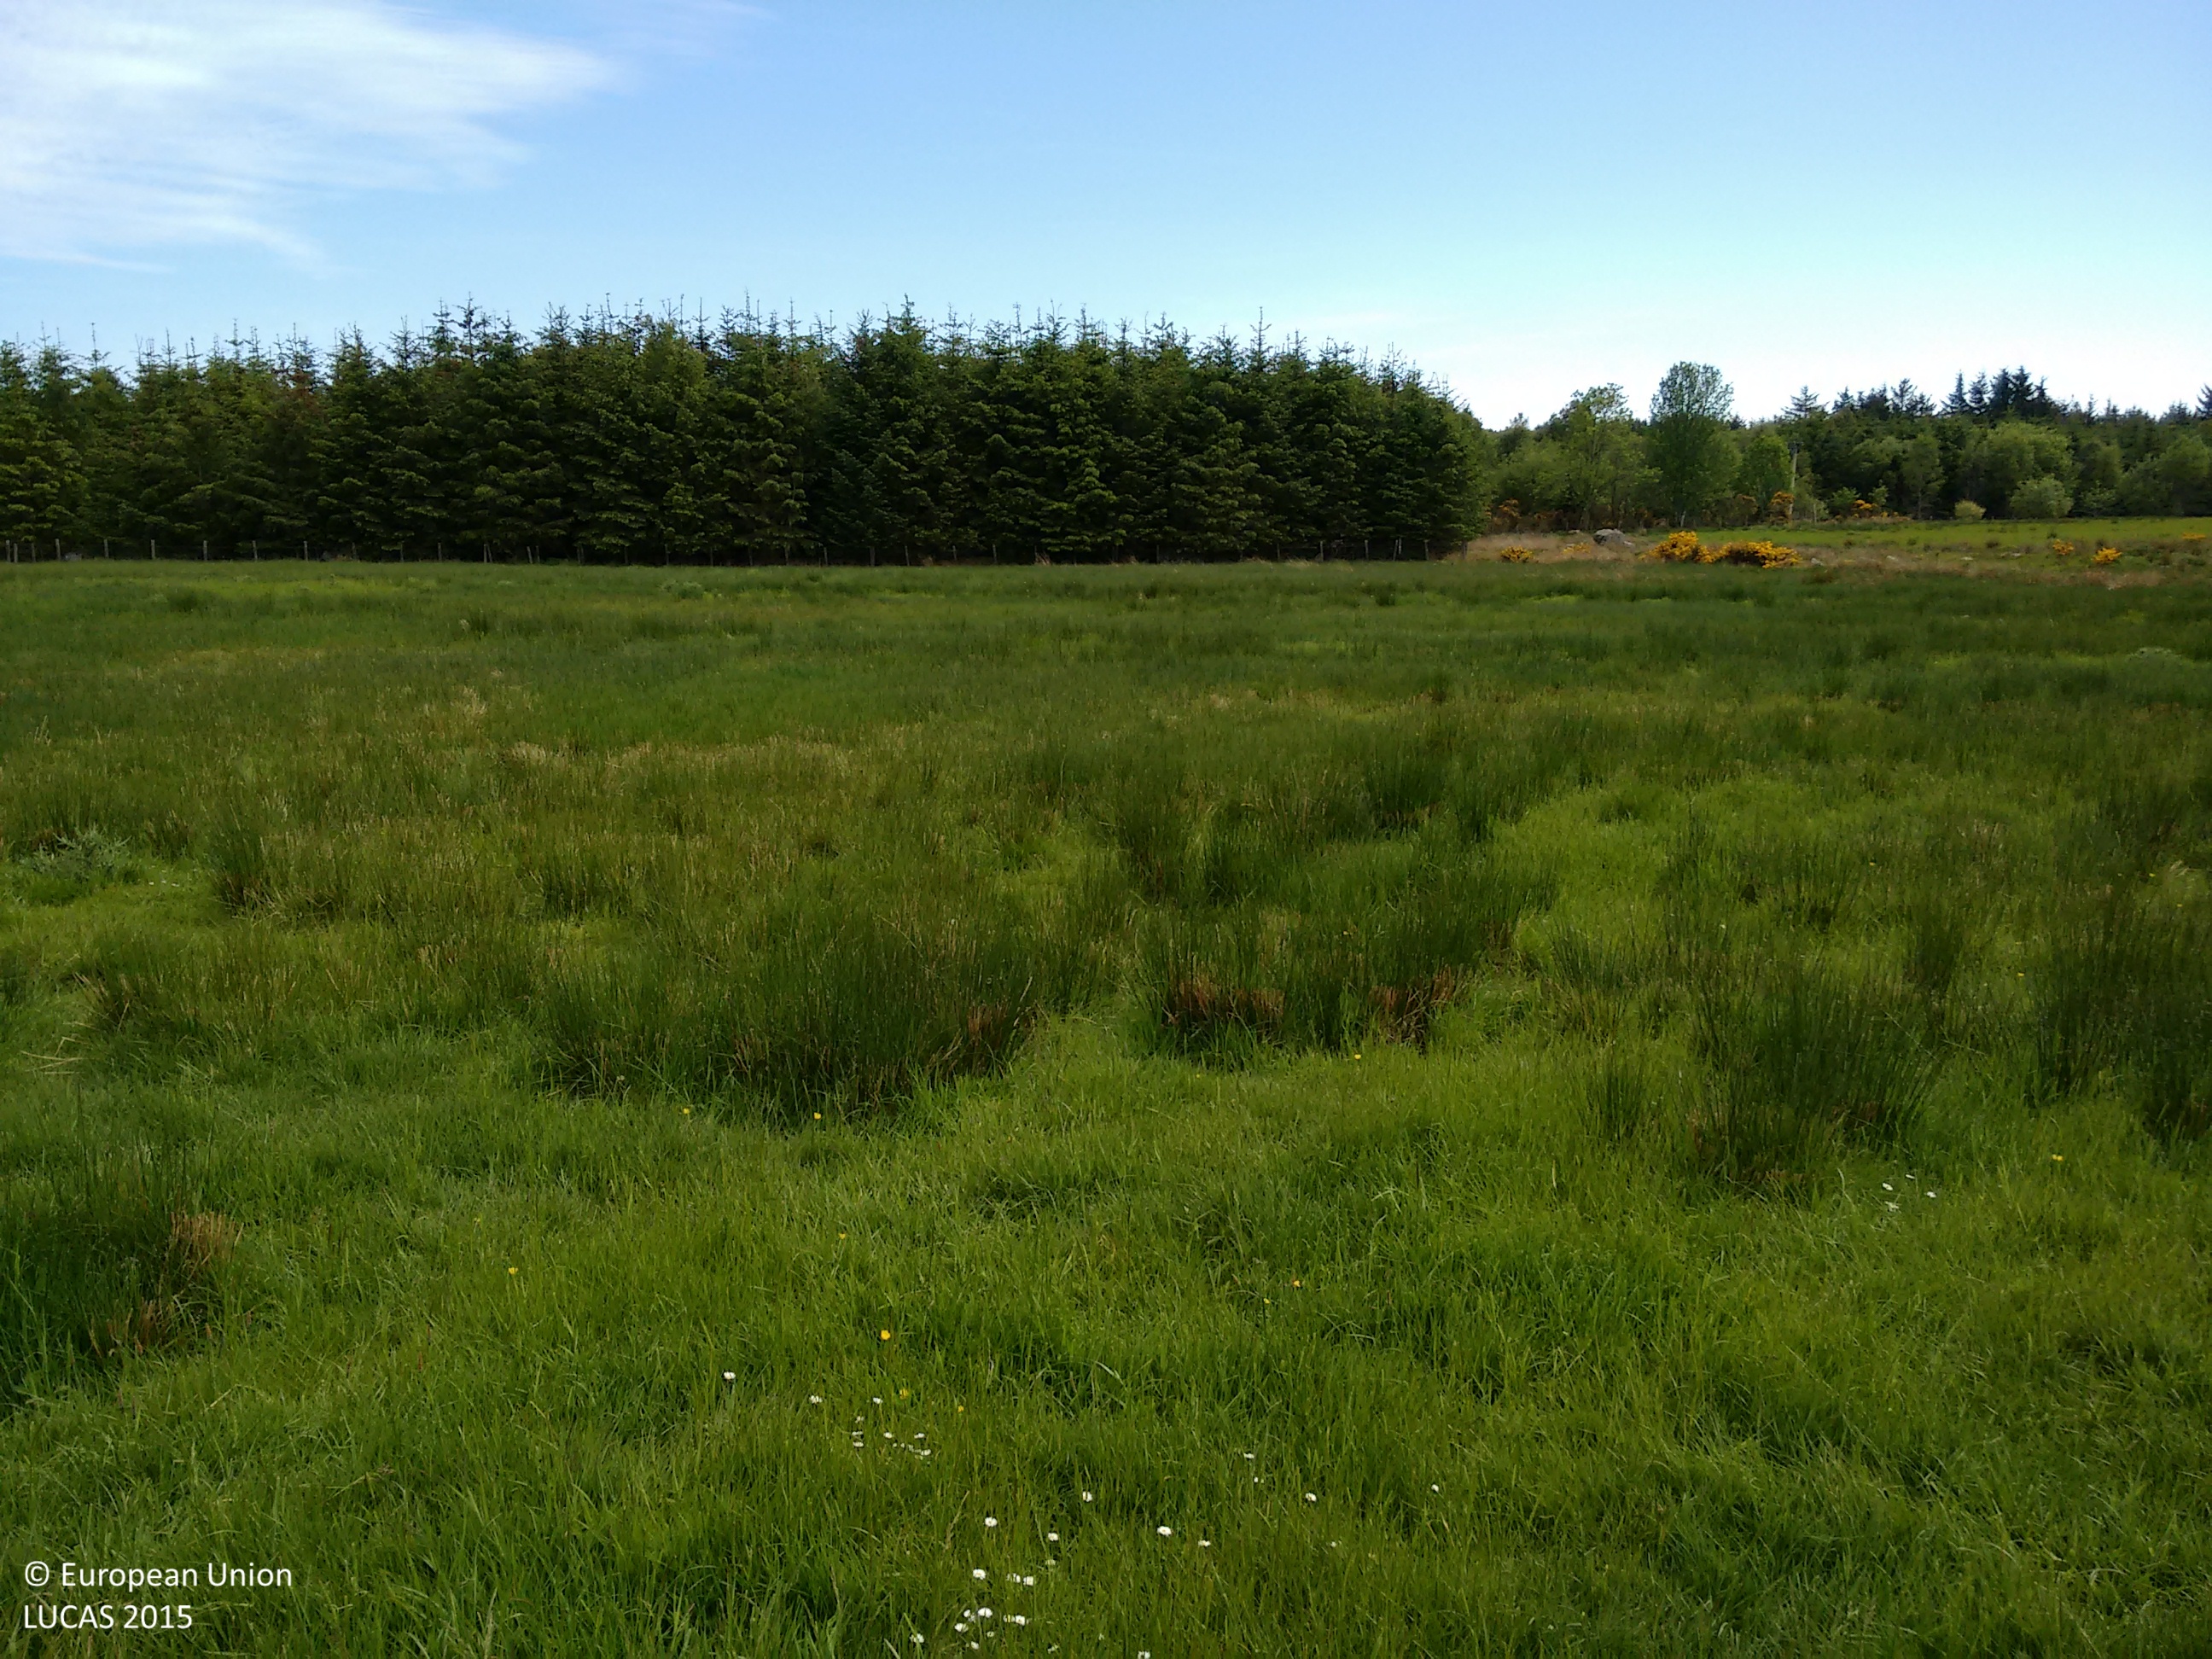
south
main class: Grassland
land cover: Grassland without tree/shrub cover
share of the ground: > 75 %
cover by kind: herbaceous plants 100 %
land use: Agriculture (excluding fallow land and kitchen gardens)
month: June
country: GB
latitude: 57.0743
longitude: -2.2409
